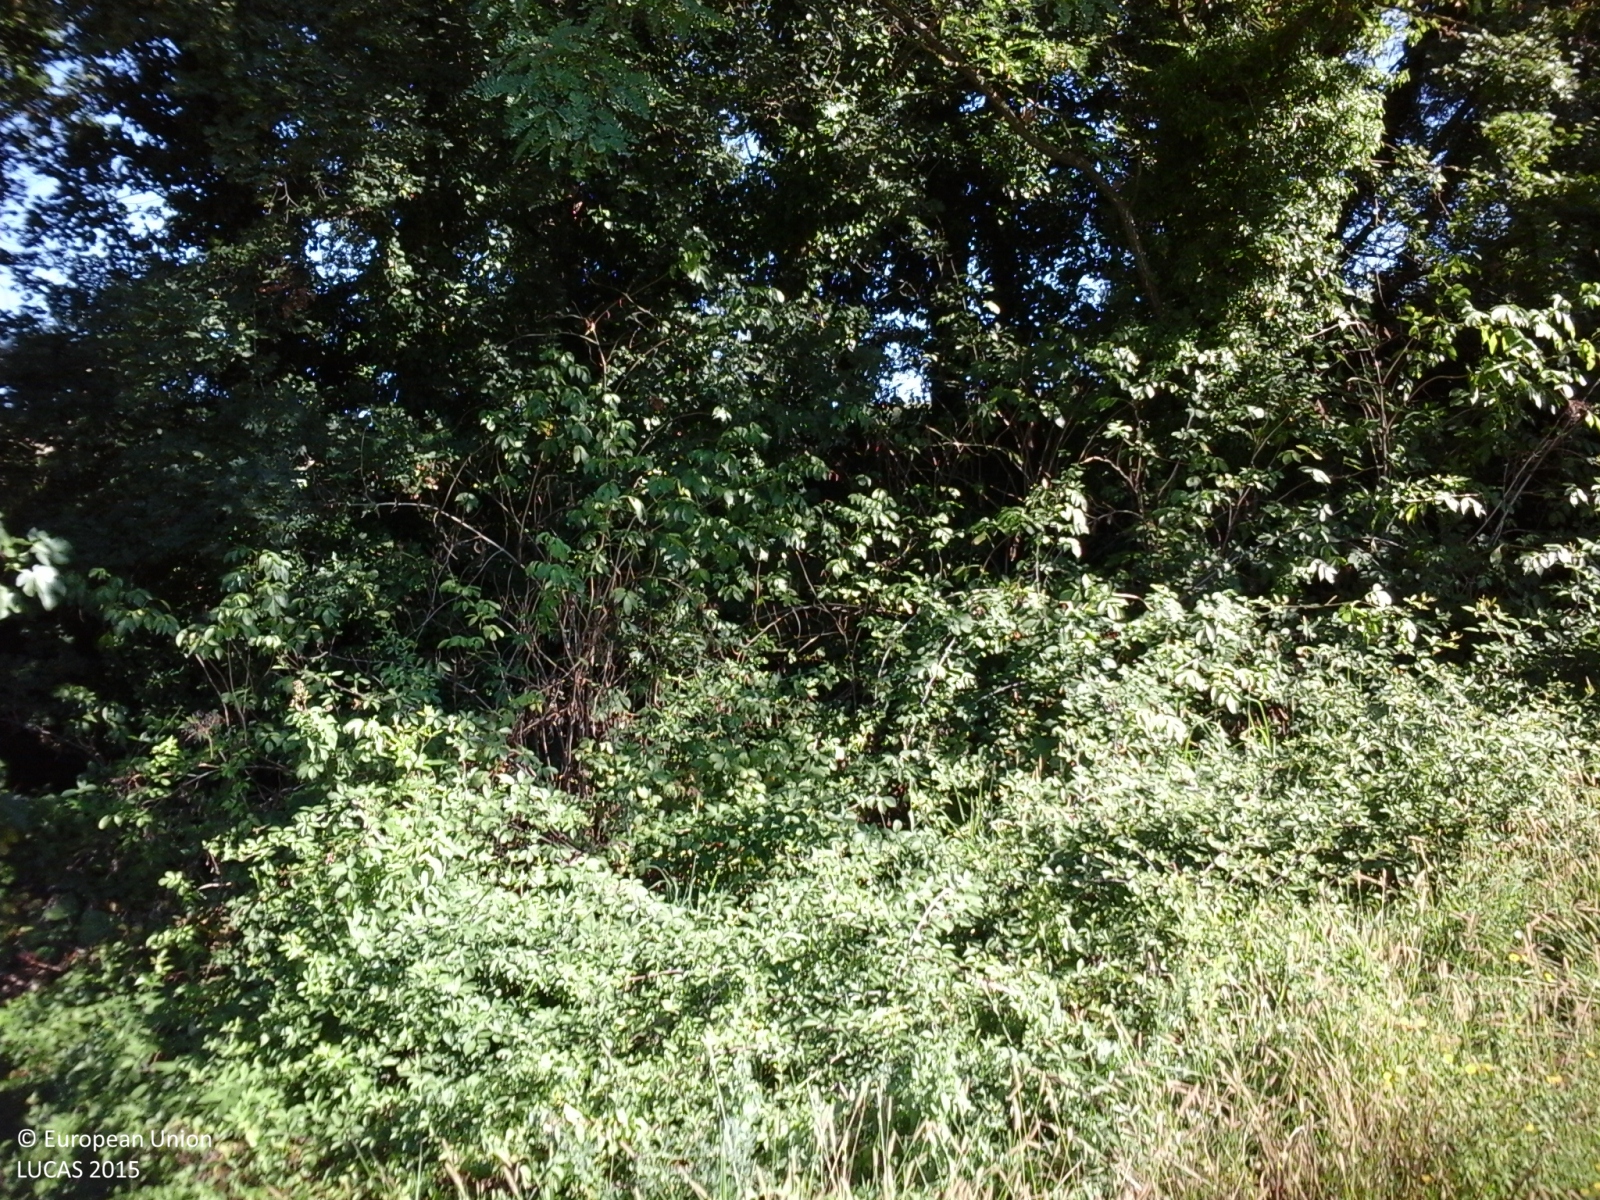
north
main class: Cropland
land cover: Lucerne
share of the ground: > 75 %
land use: Agriculture (excluding fallow land and kitchen gardens)
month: August
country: IT
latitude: 43.0859
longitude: 13.3689
